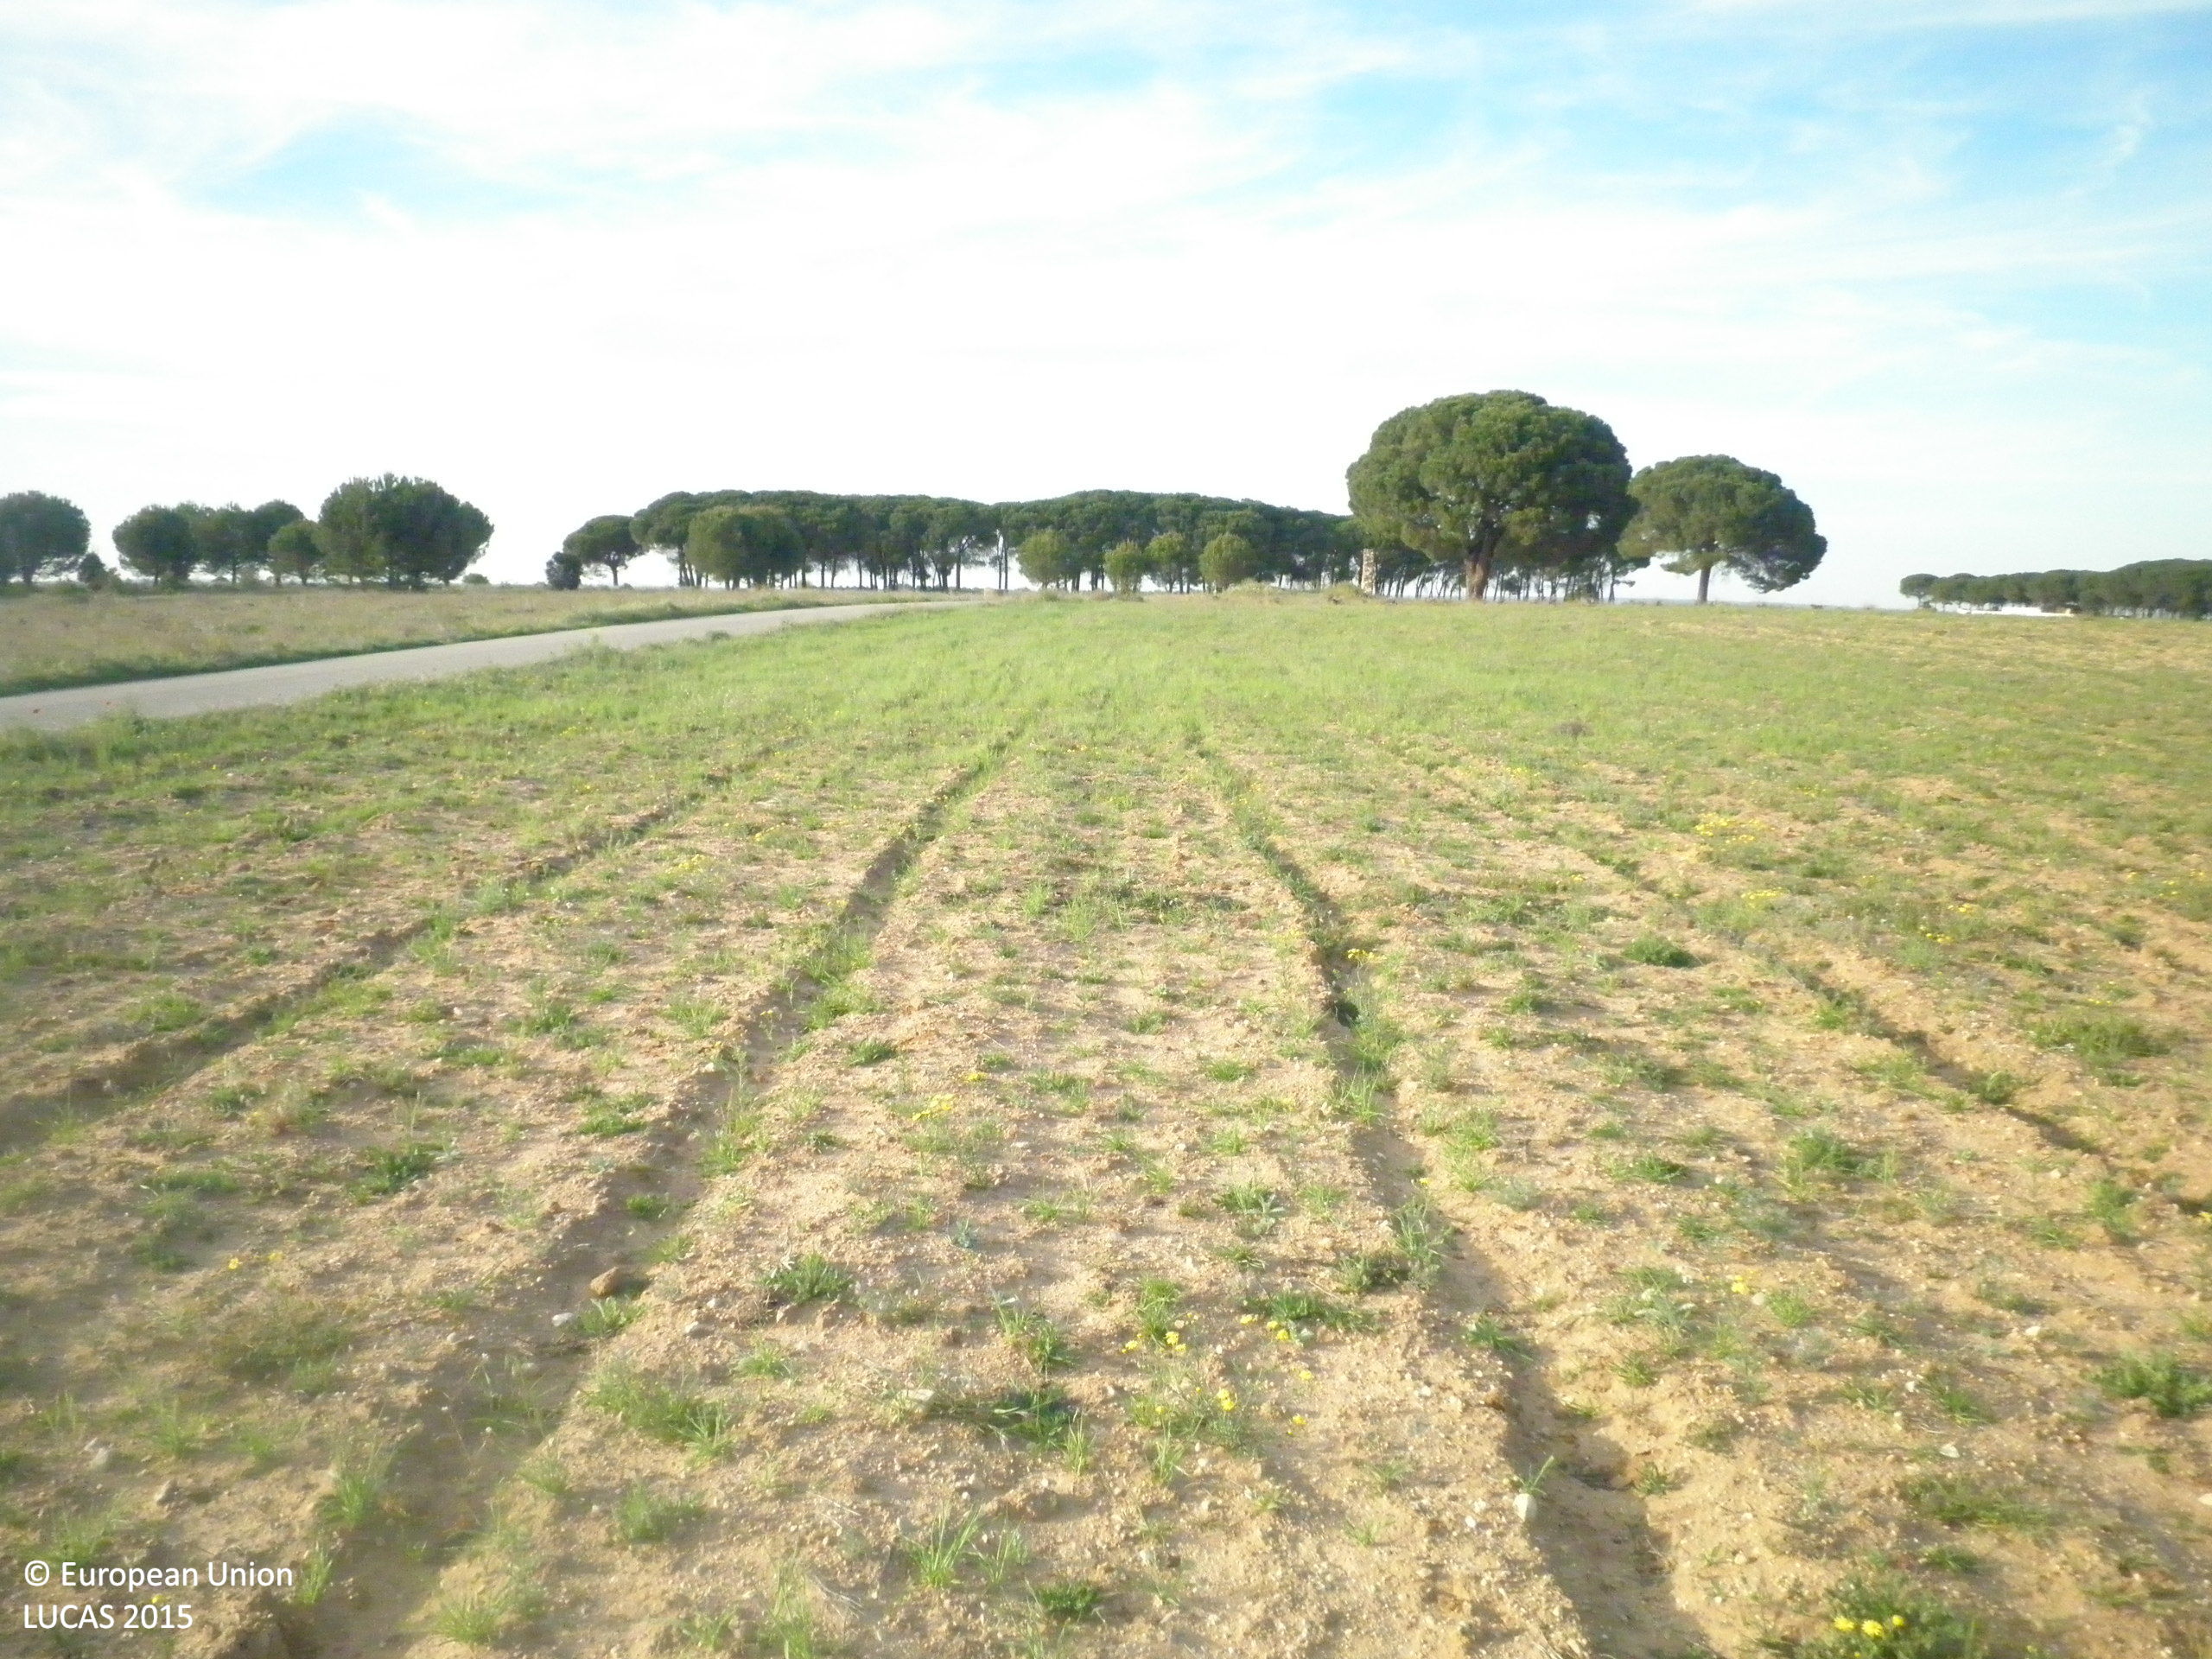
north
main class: Grassland
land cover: Spontaneously vegetated surfaces
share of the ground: 10 - 25 %
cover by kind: unconsolidated bare surface 75 %, herbaceous plants 25 %
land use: Fallow land
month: April
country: ES
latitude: 39.3385
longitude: -2.7633
